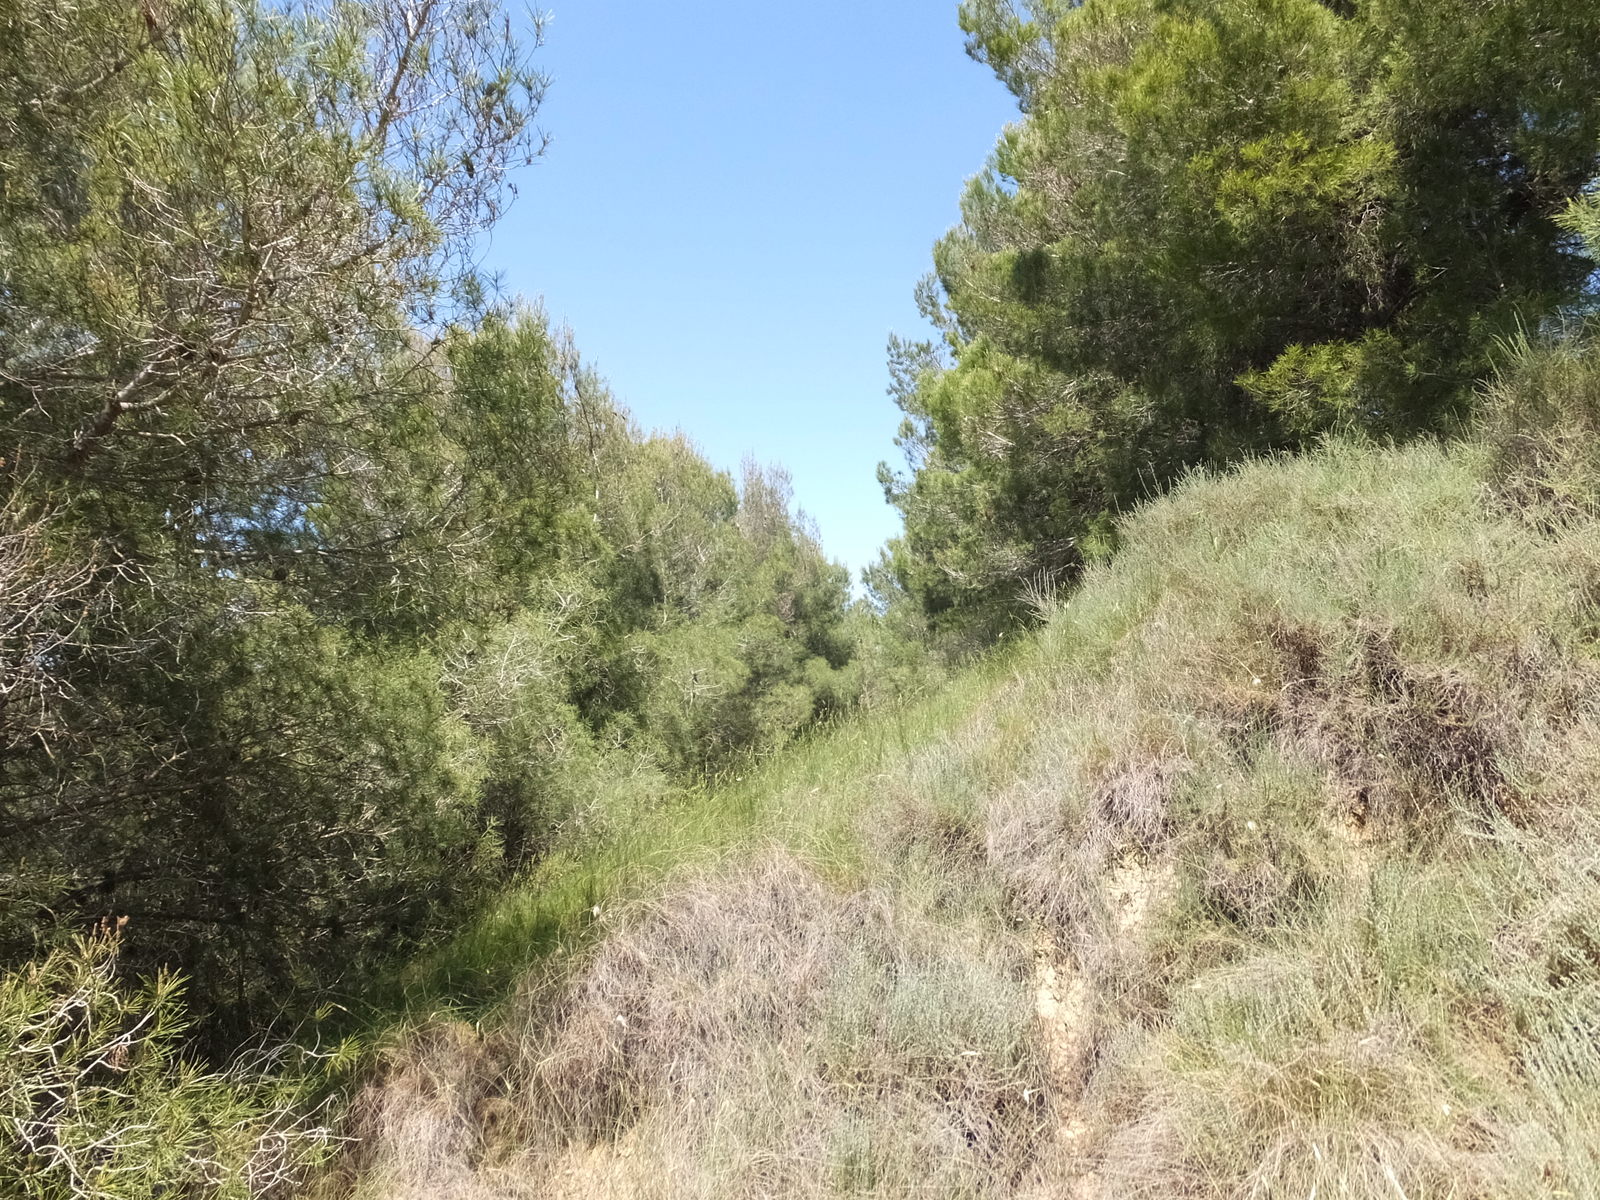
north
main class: Woodland
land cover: Pine dominated coniferous woodland
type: coniferous forest of the mediterranean region
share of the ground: > 75 %
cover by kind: coniferous forest trees 70 %, shrubs 15 %, herbaceous plants 15 %
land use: Semi-natural and natural areas not in use
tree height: > 5 m
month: May
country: ES
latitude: 41.7983
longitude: -0.1392
